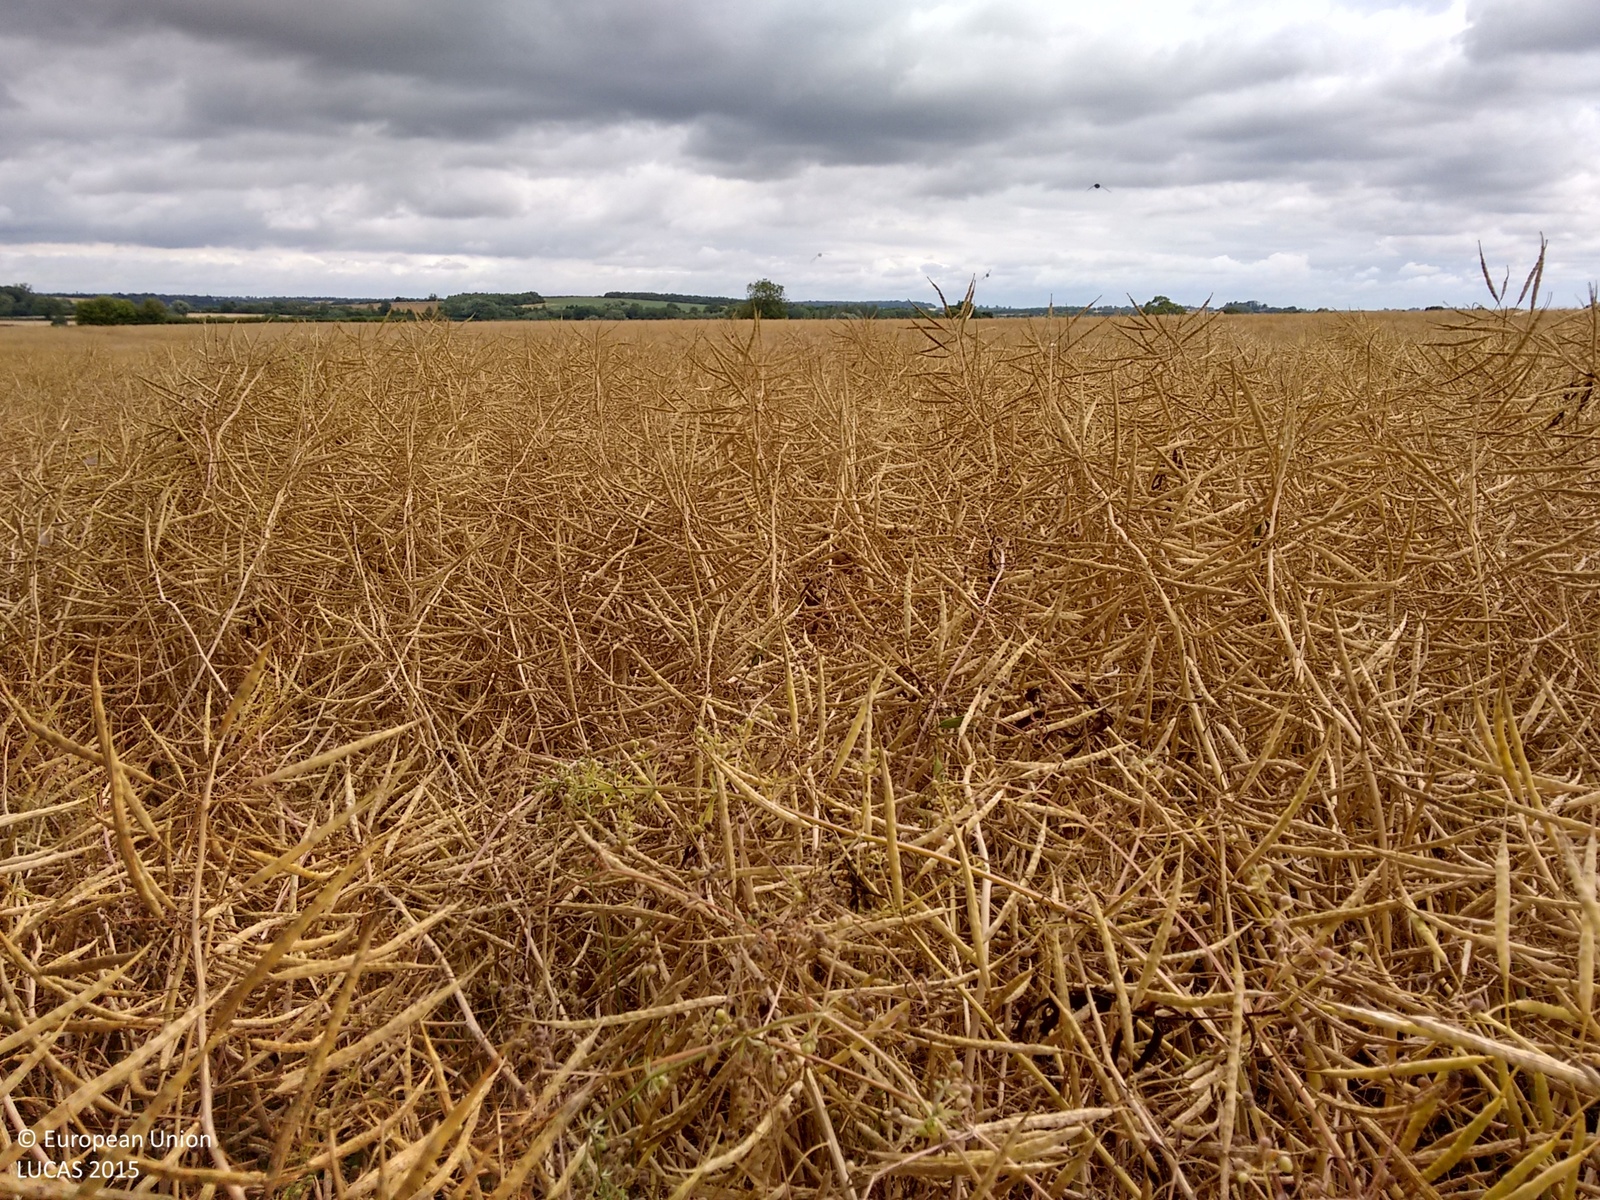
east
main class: Cropland
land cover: Rape and turnip rape
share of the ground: > 75 %
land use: Agriculture (excluding fallow land and kitchen gardens)
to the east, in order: Rape and turnip rape
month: July
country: GB
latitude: 52.7378
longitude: -0.7792
